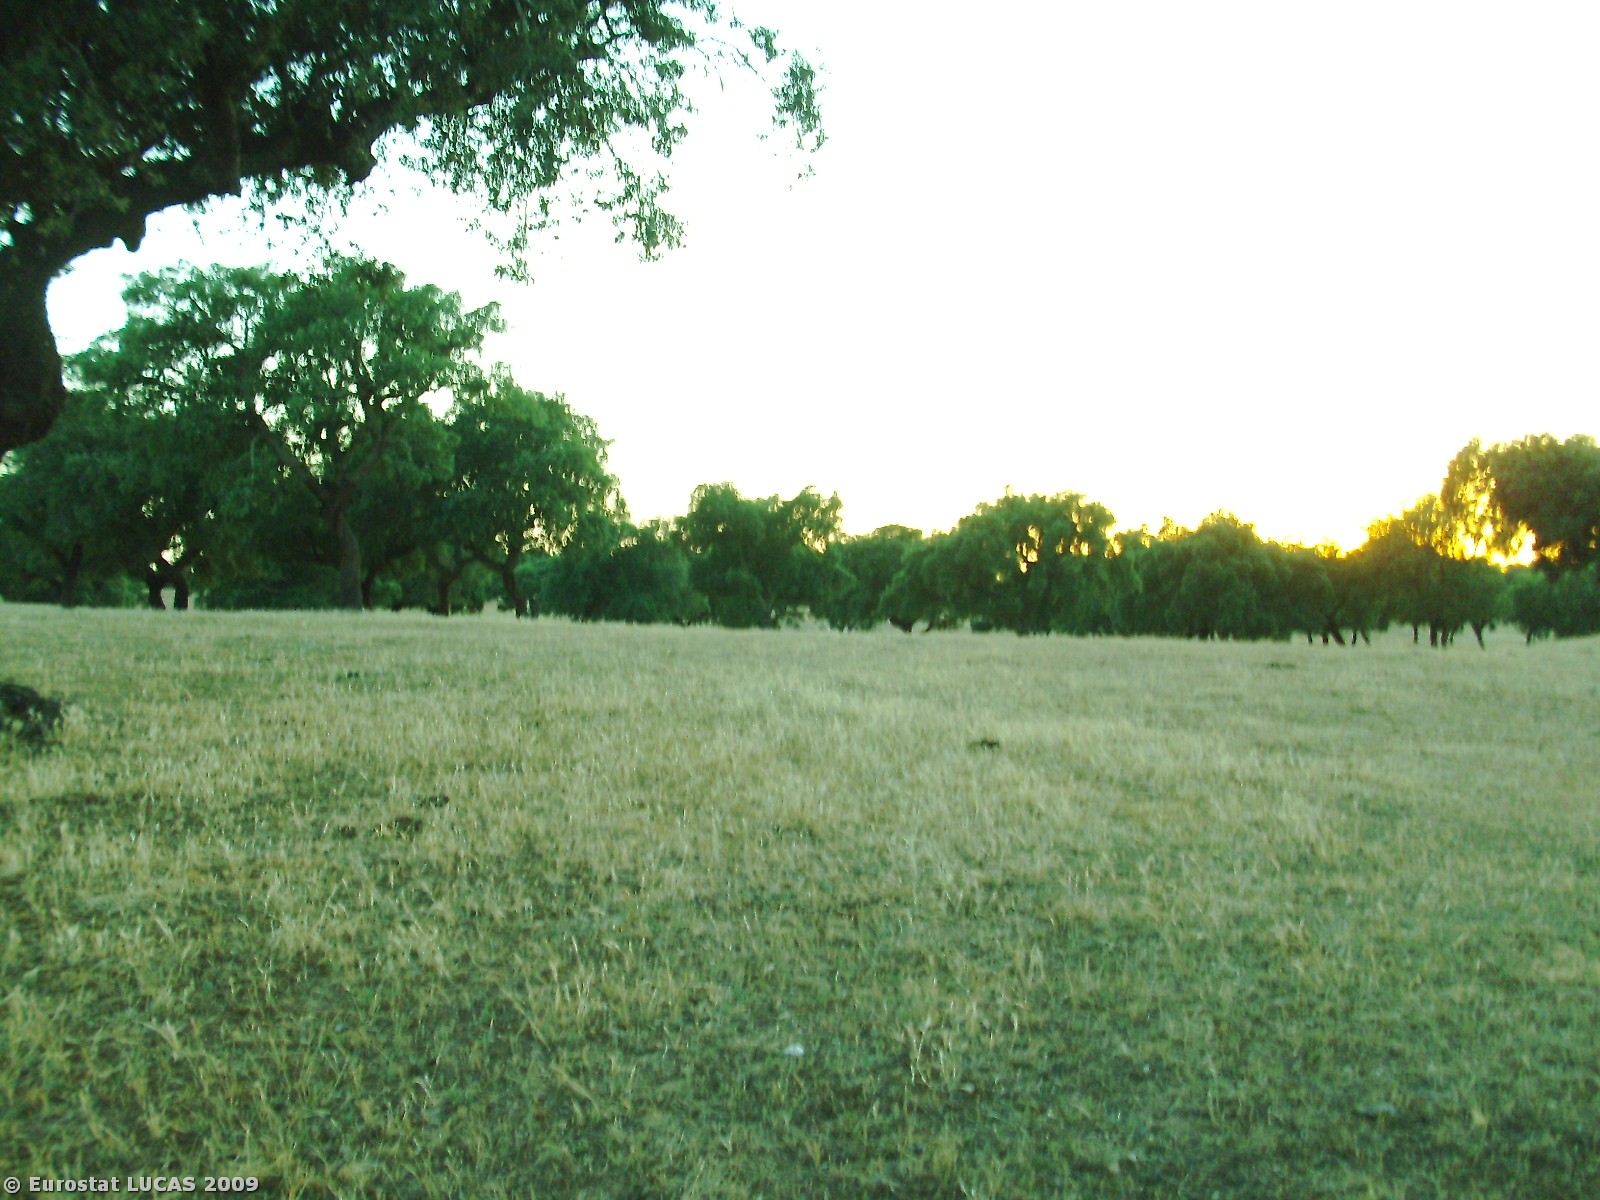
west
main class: Grassland
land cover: Grassland with sparse tree/shrub cover
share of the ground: > 75 %
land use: Agriculture (excluding fallow land and kitchen gardens)
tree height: > 5 m
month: May
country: PT
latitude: 38.9518
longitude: -7.3297
